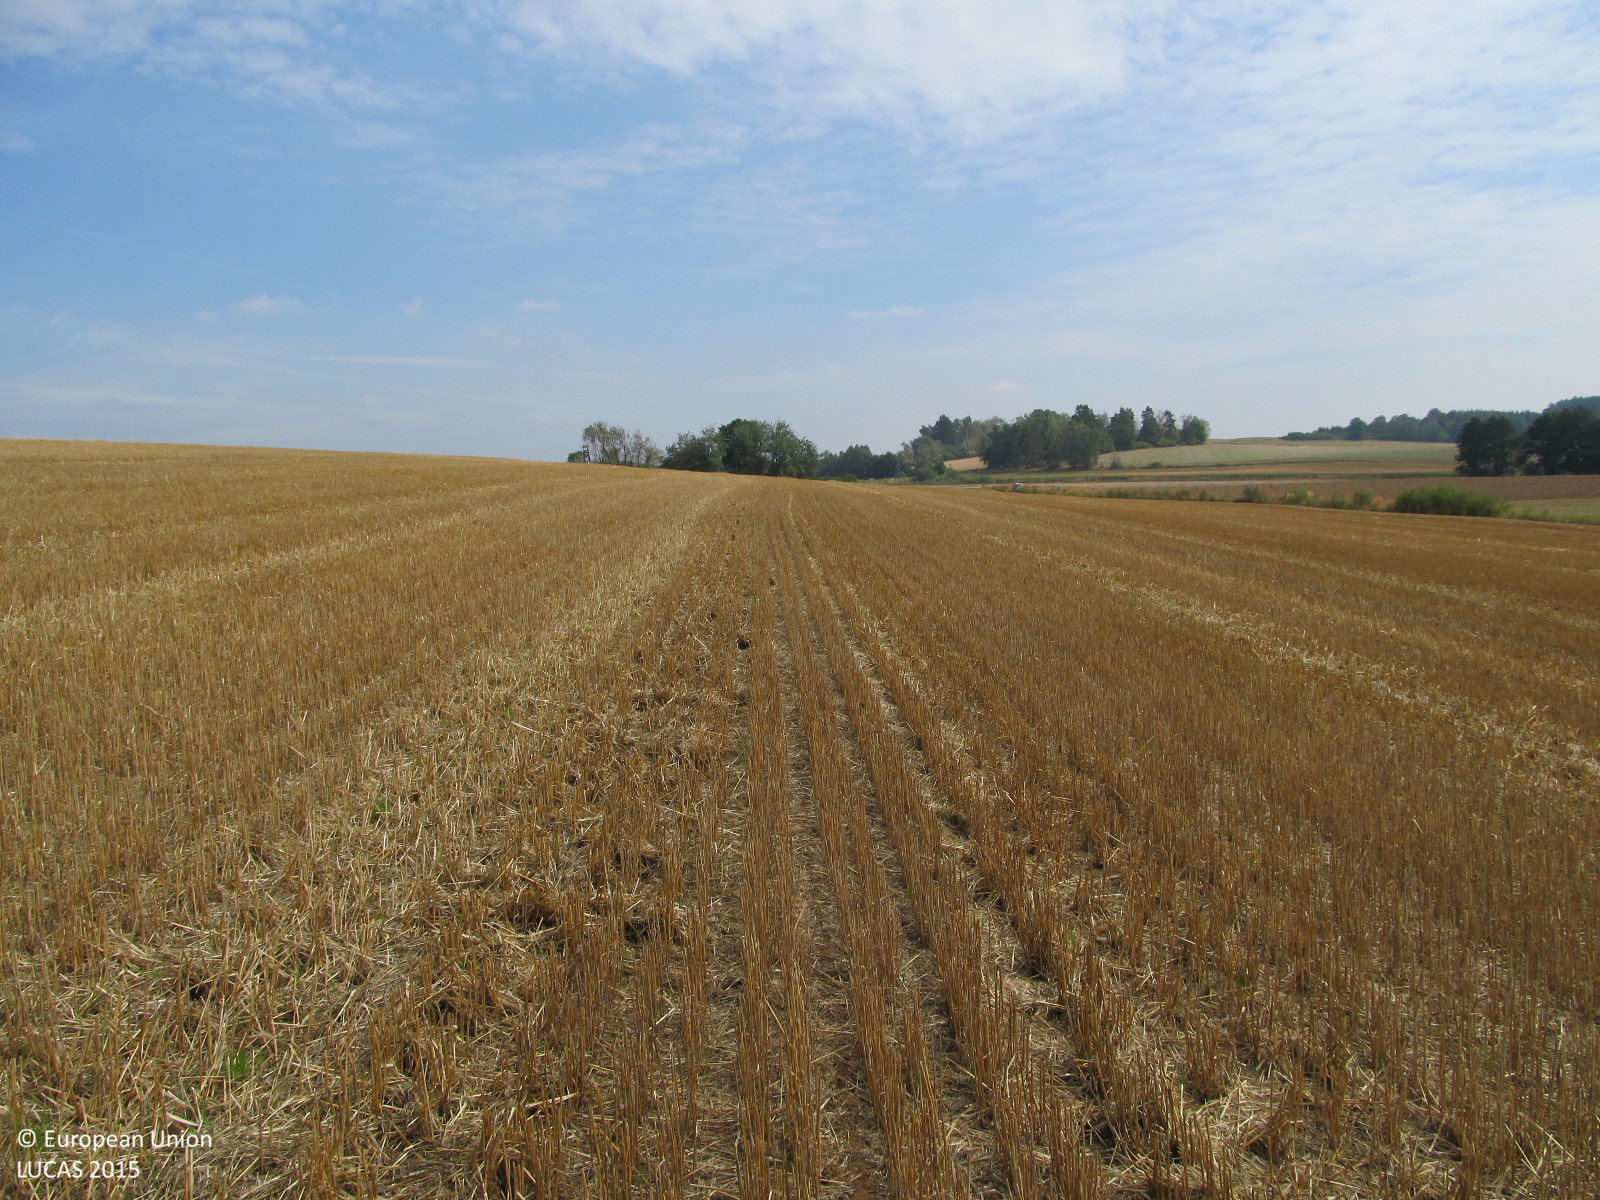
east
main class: Cropland
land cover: Common wheat
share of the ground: 25 - 50 %
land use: Agriculture (excluding fallow land and kitchen gardens)
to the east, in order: Common wheat; Broadleaved woodland
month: August
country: AT
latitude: 48.8646
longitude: 15.4422
